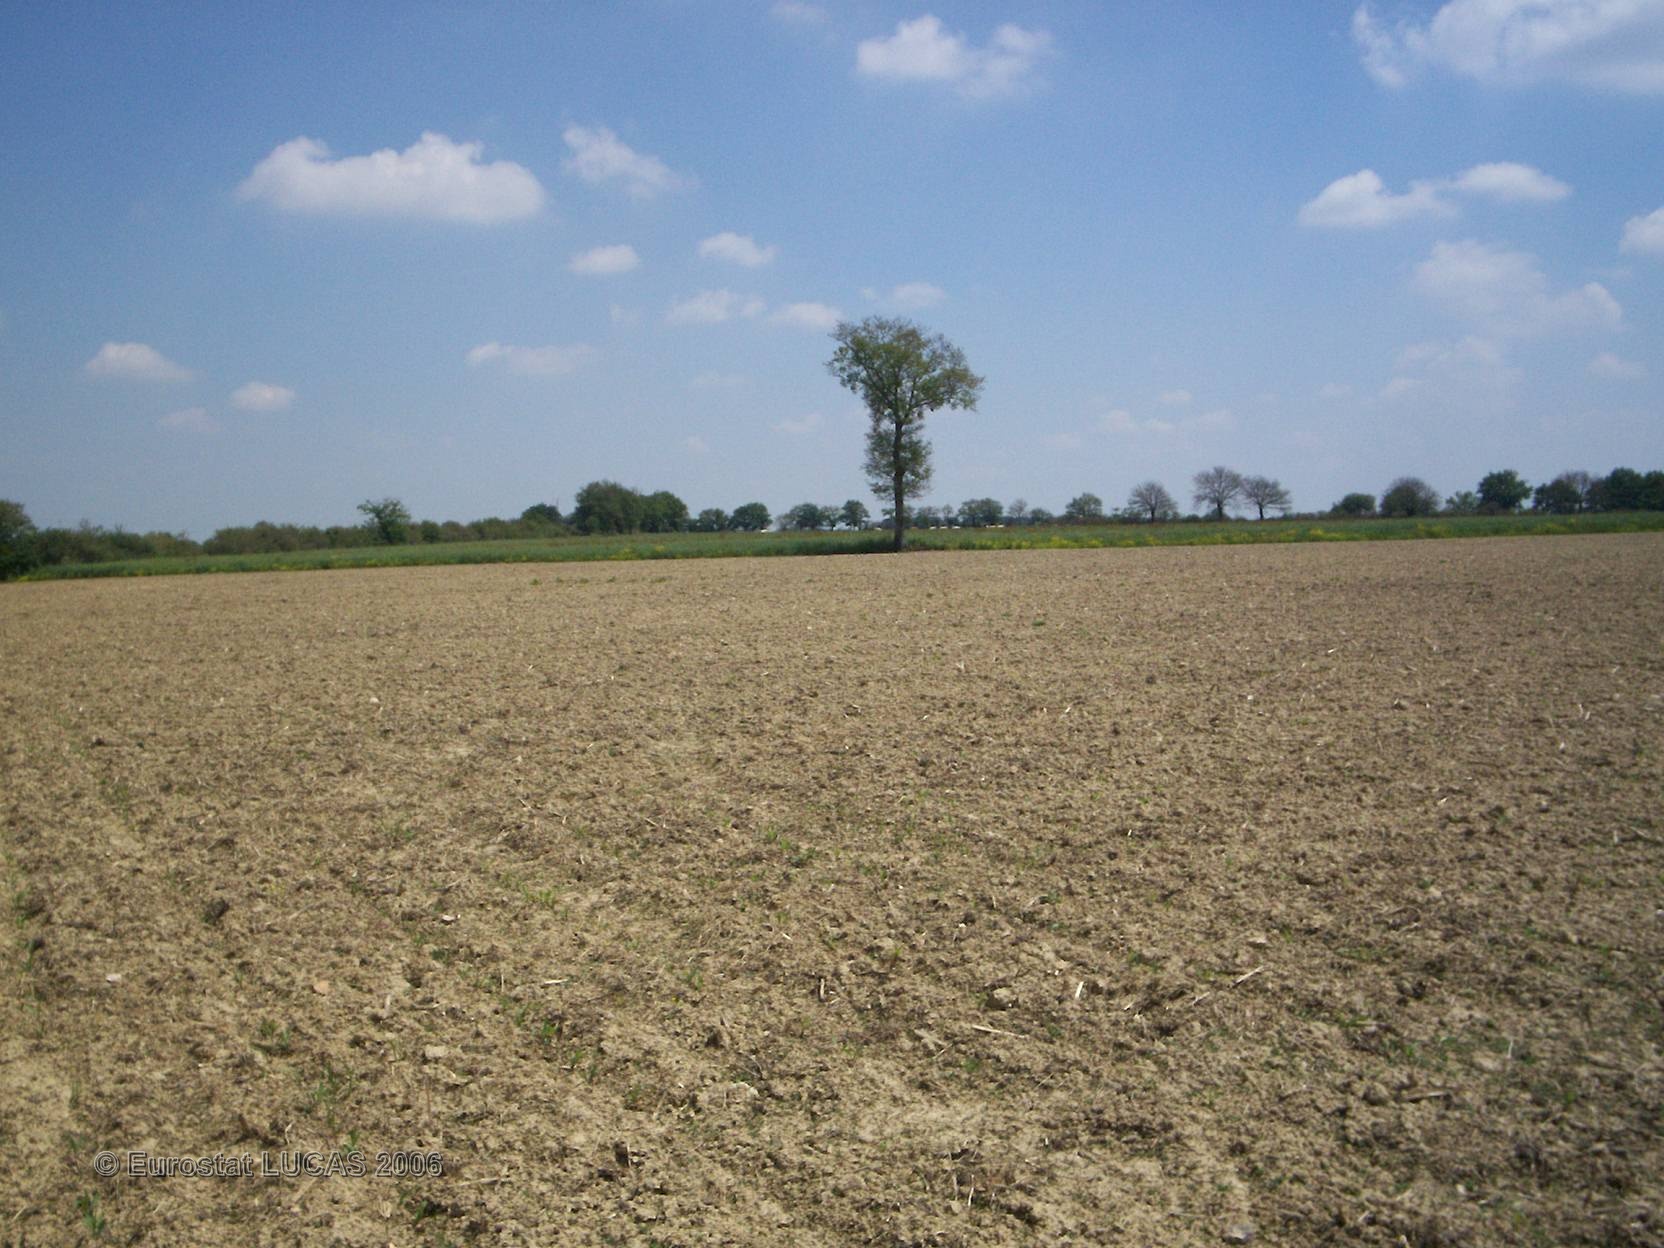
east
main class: Cropland
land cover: Maize
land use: Agriculture (excluding fallow land and kitchen gardens)
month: June
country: FR
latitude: 47.6020
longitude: -1.1451
